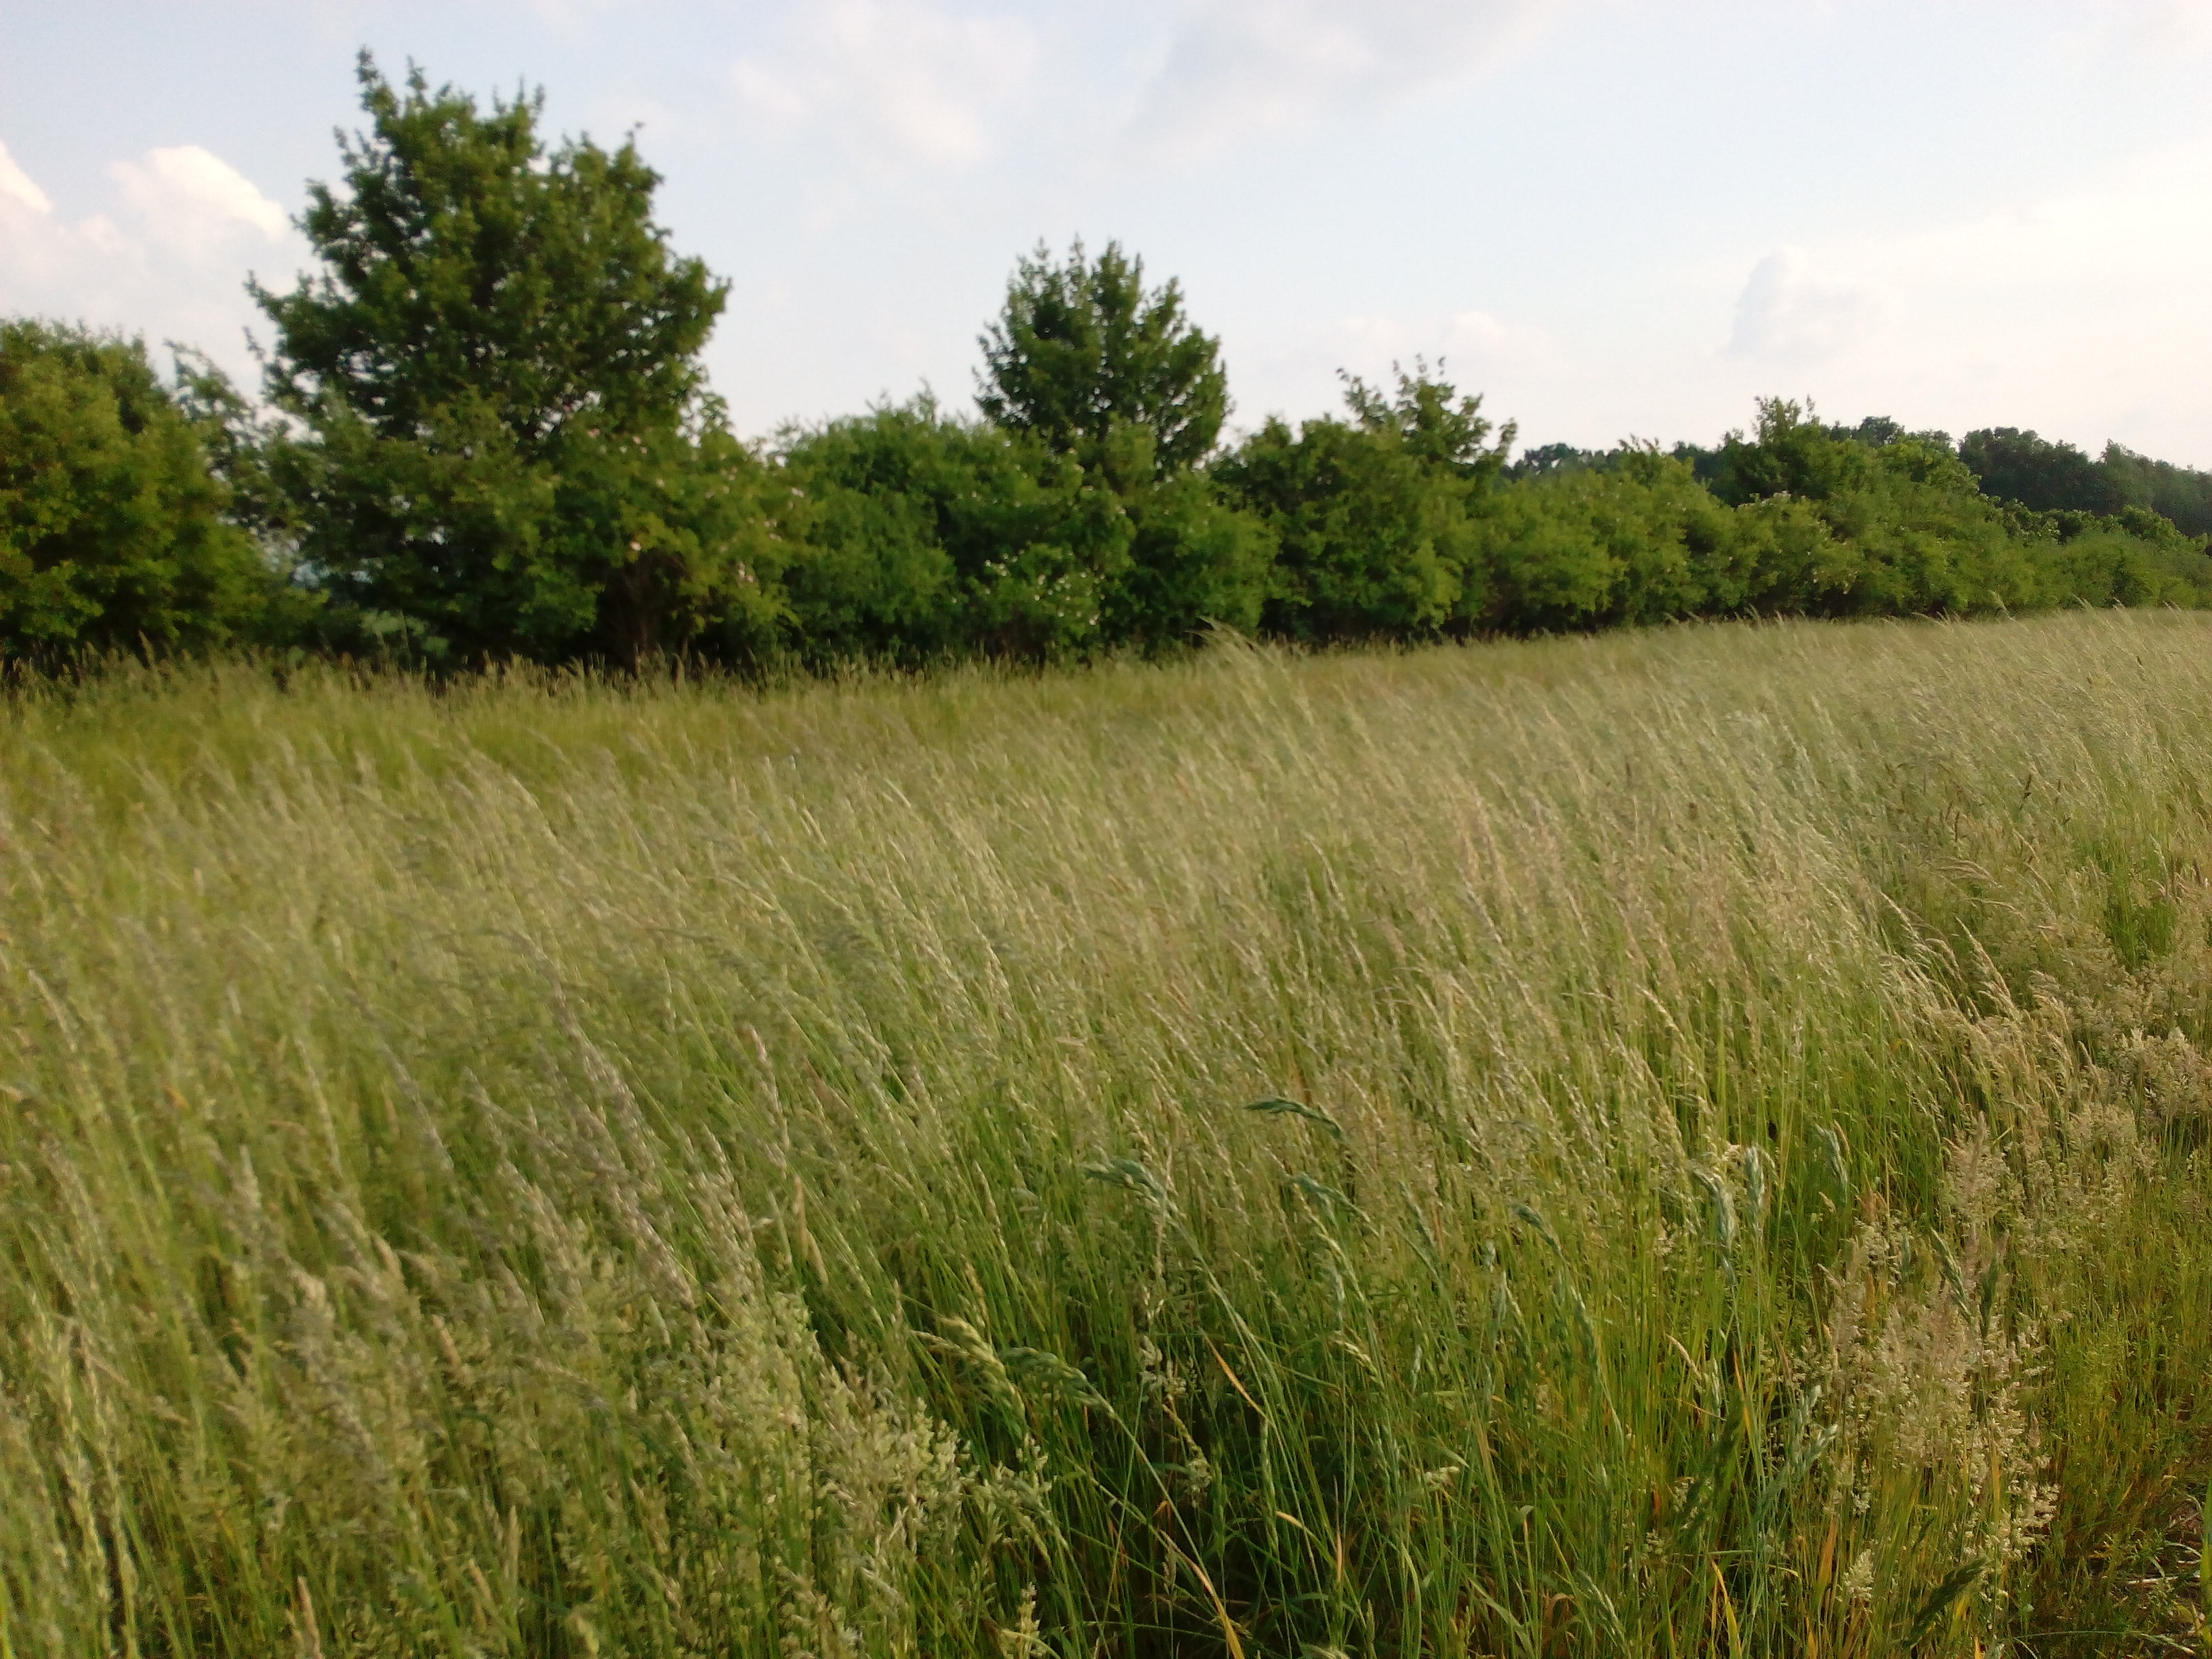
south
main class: Cropland
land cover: Common wheat
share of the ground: > 75 %
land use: Agriculture (excluding fallow land and kitchen gardens)
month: June
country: DE
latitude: 50.9376
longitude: 10.6402
